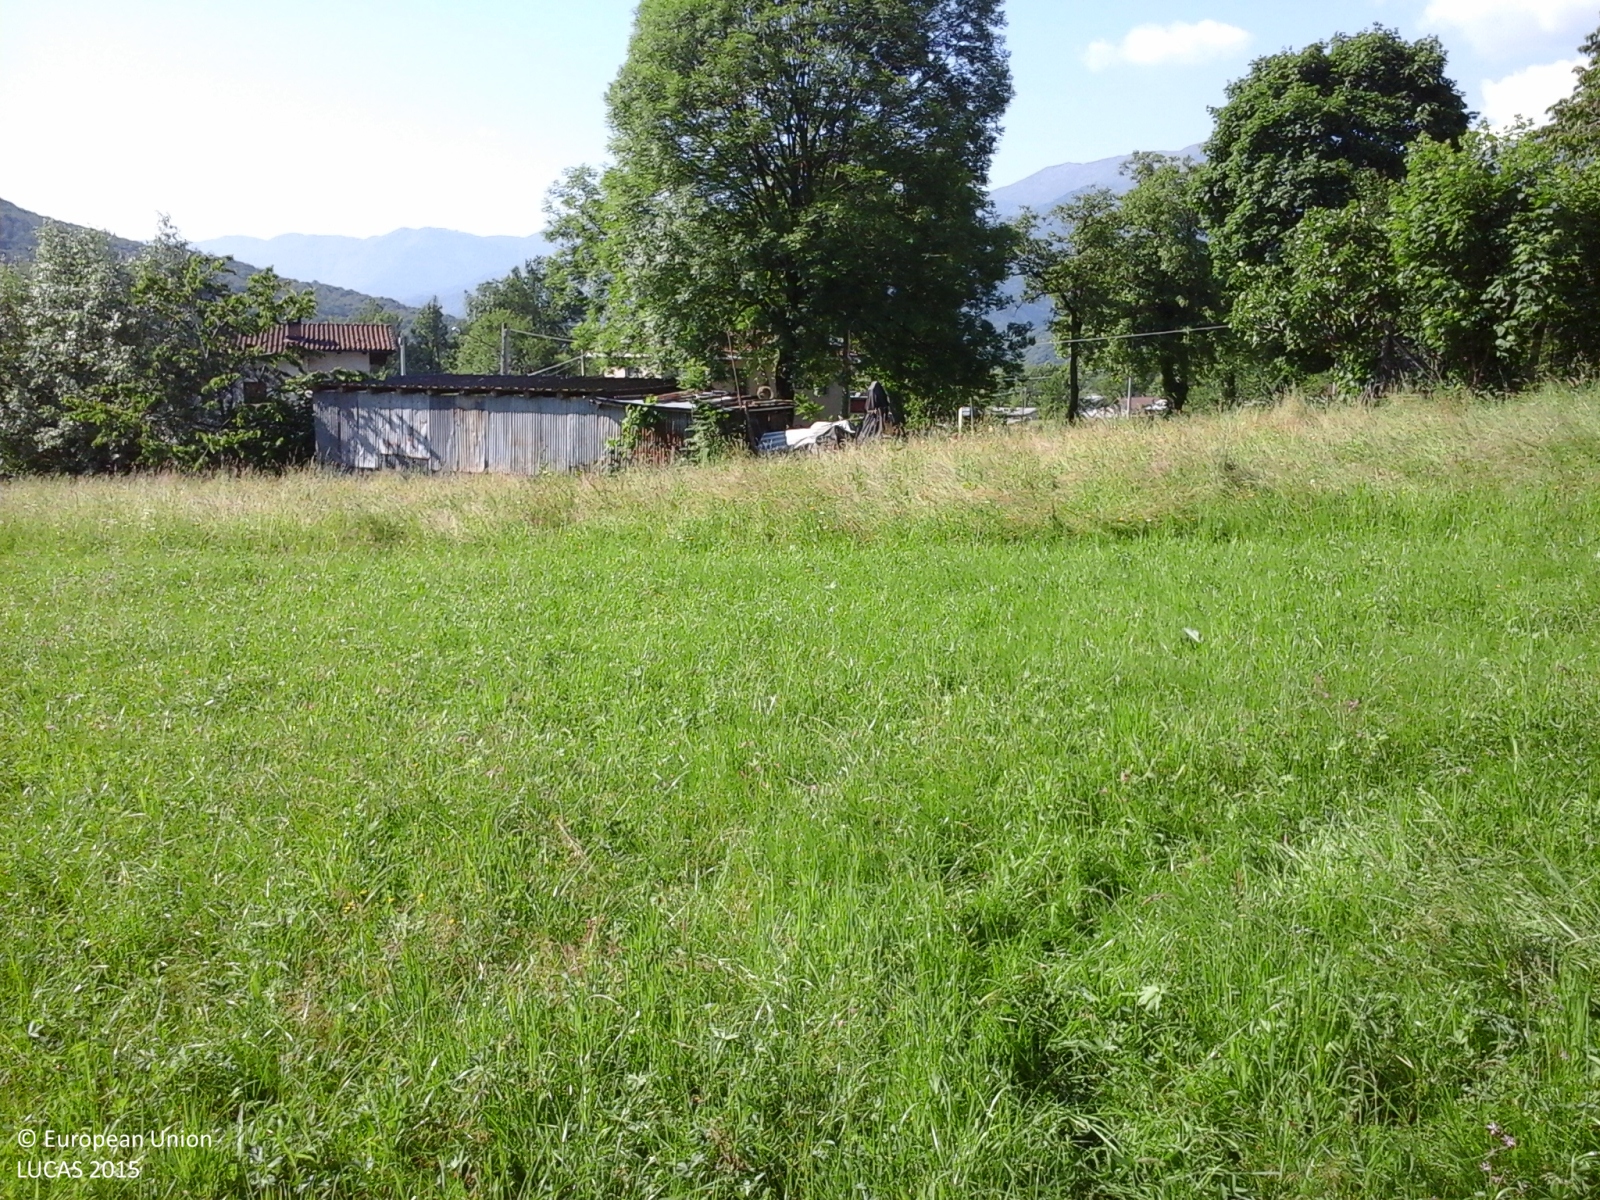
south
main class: Grassland
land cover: Grassland without tree/shrub cover
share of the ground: > 75 %
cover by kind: herbaceous plants 100 %
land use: Agriculture (excluding fallow land and kitchen gardens)
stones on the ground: 25 - 50 %
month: May
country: IT
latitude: 44.6942
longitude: 7.2920
